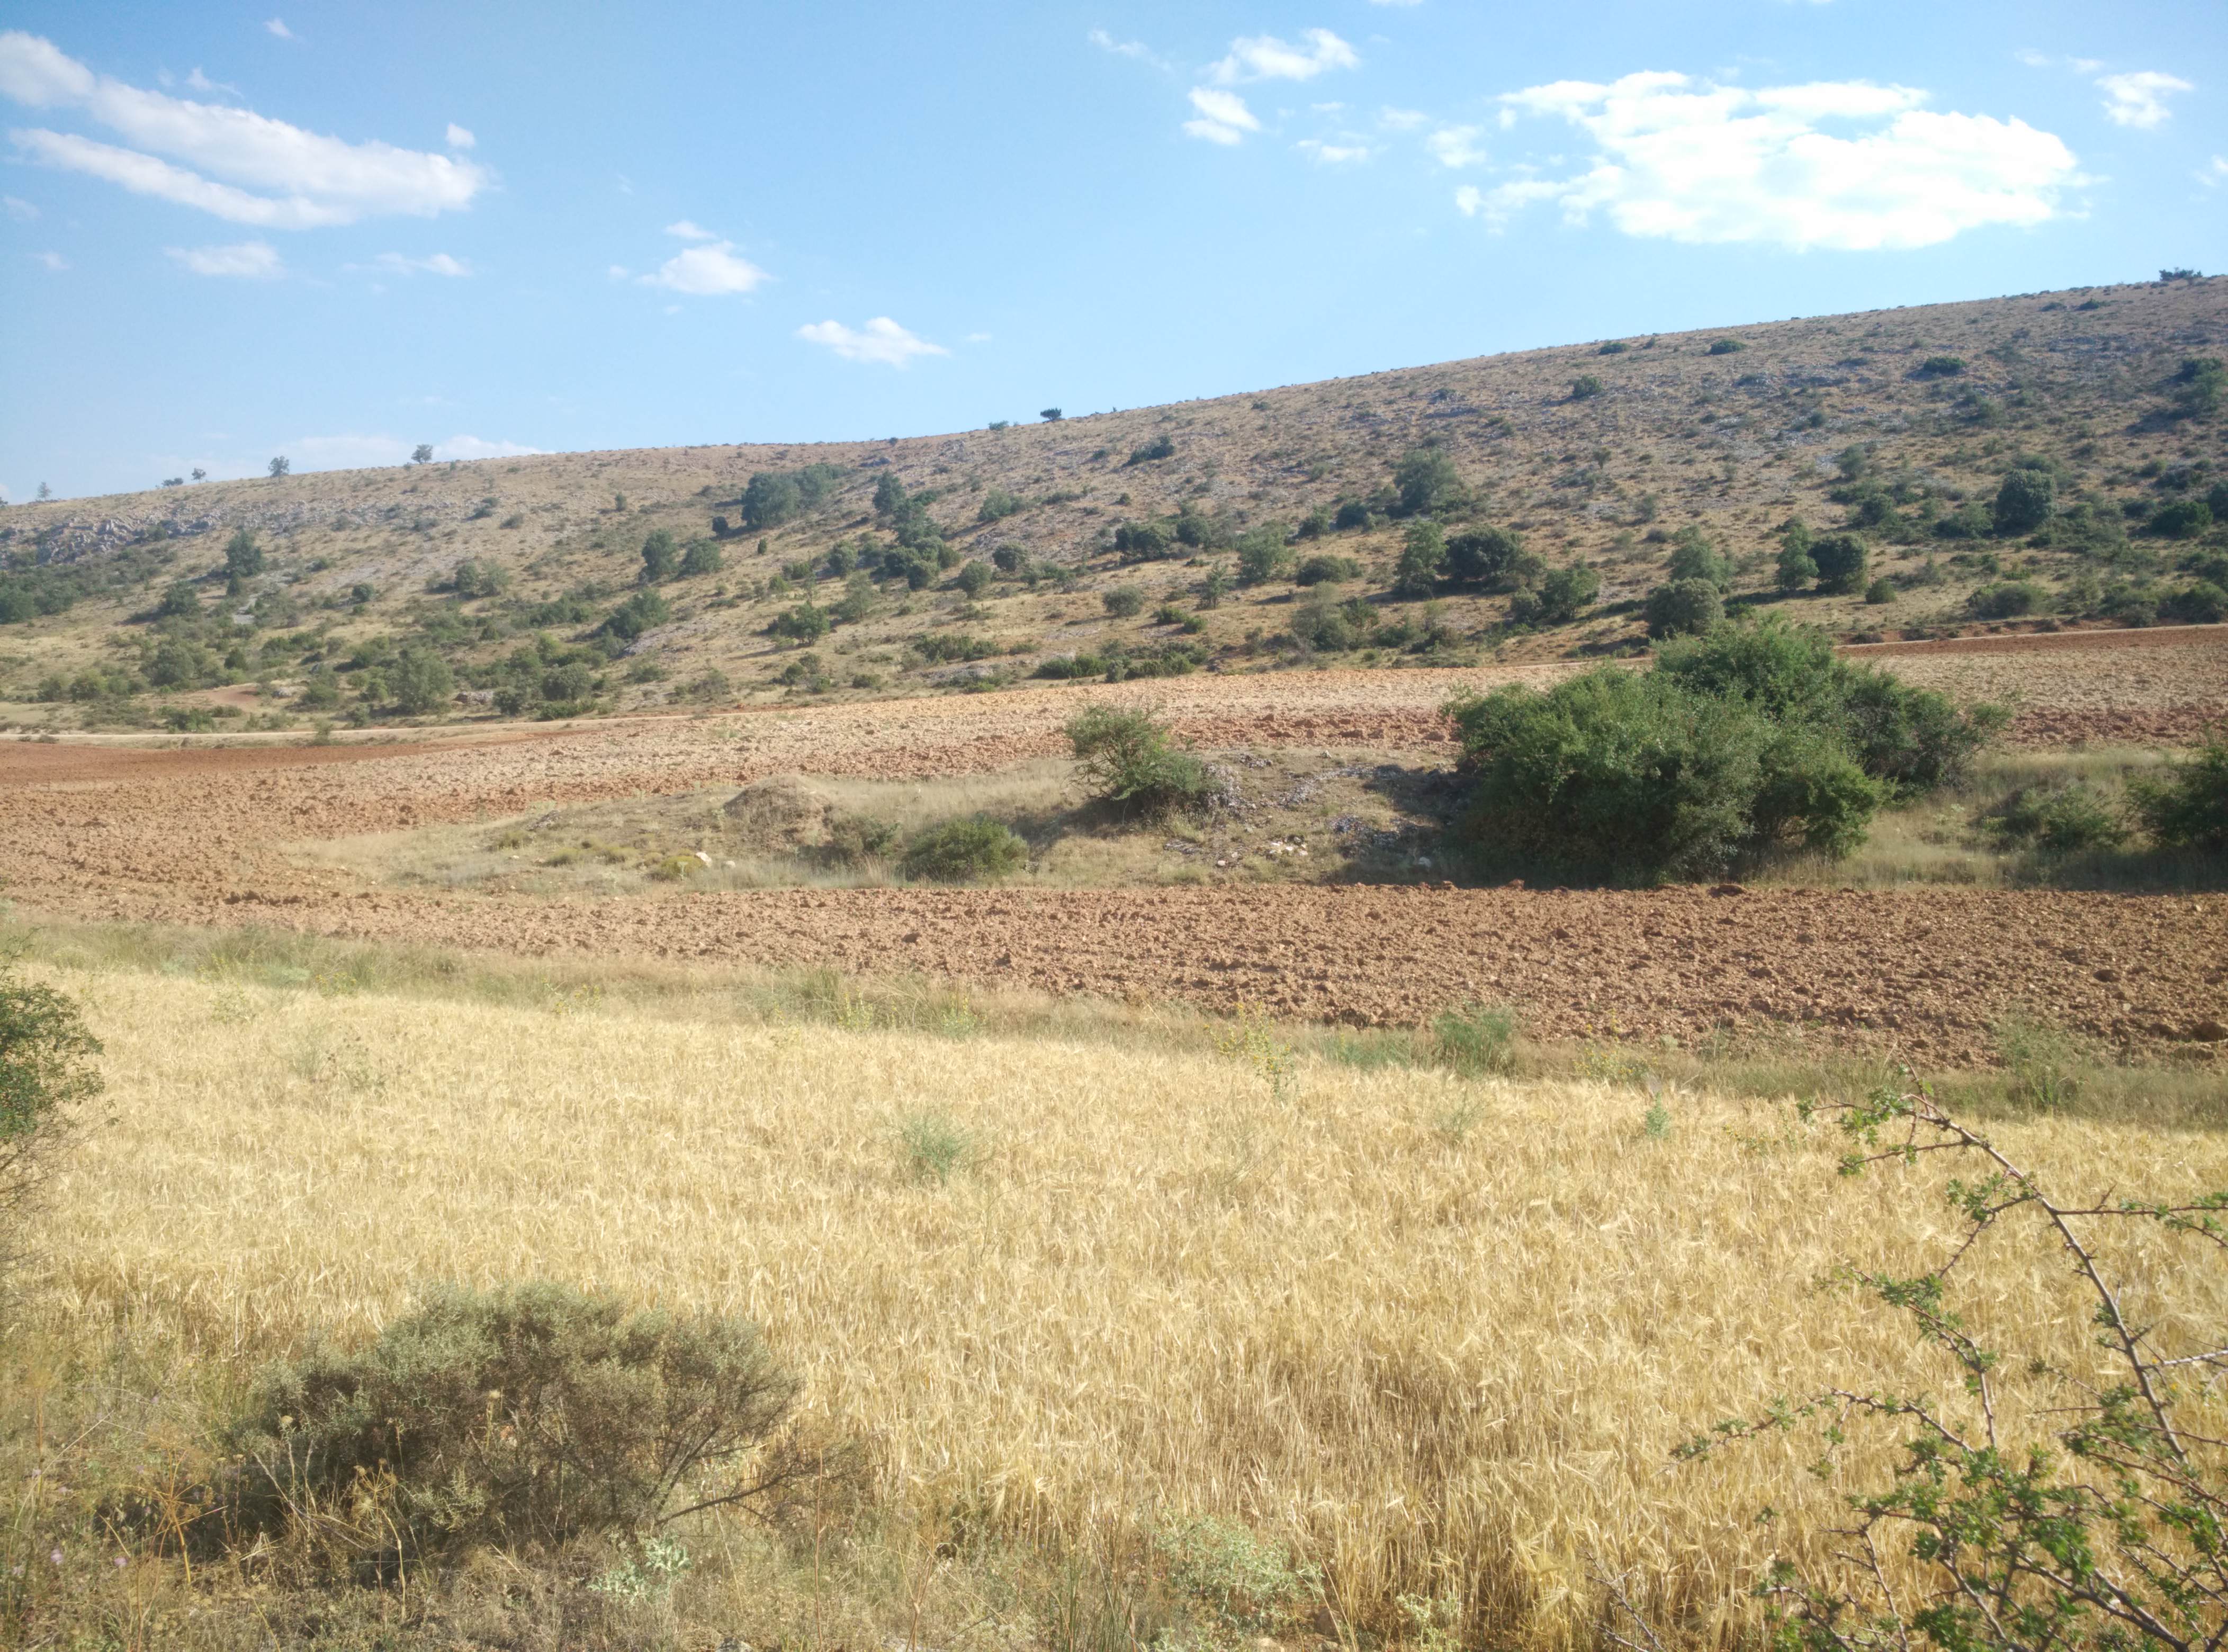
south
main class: Shrubland
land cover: Shrubland without tree cover
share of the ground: 10 - 25 %
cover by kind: unconsolidated bare surface 45 %, shrubs 20 %, herbaceous plants 10 %
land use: Semi-natural and natural areas not in use
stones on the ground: 10 - 25 %
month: July
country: ES
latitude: 41.0081
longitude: -2.1423
